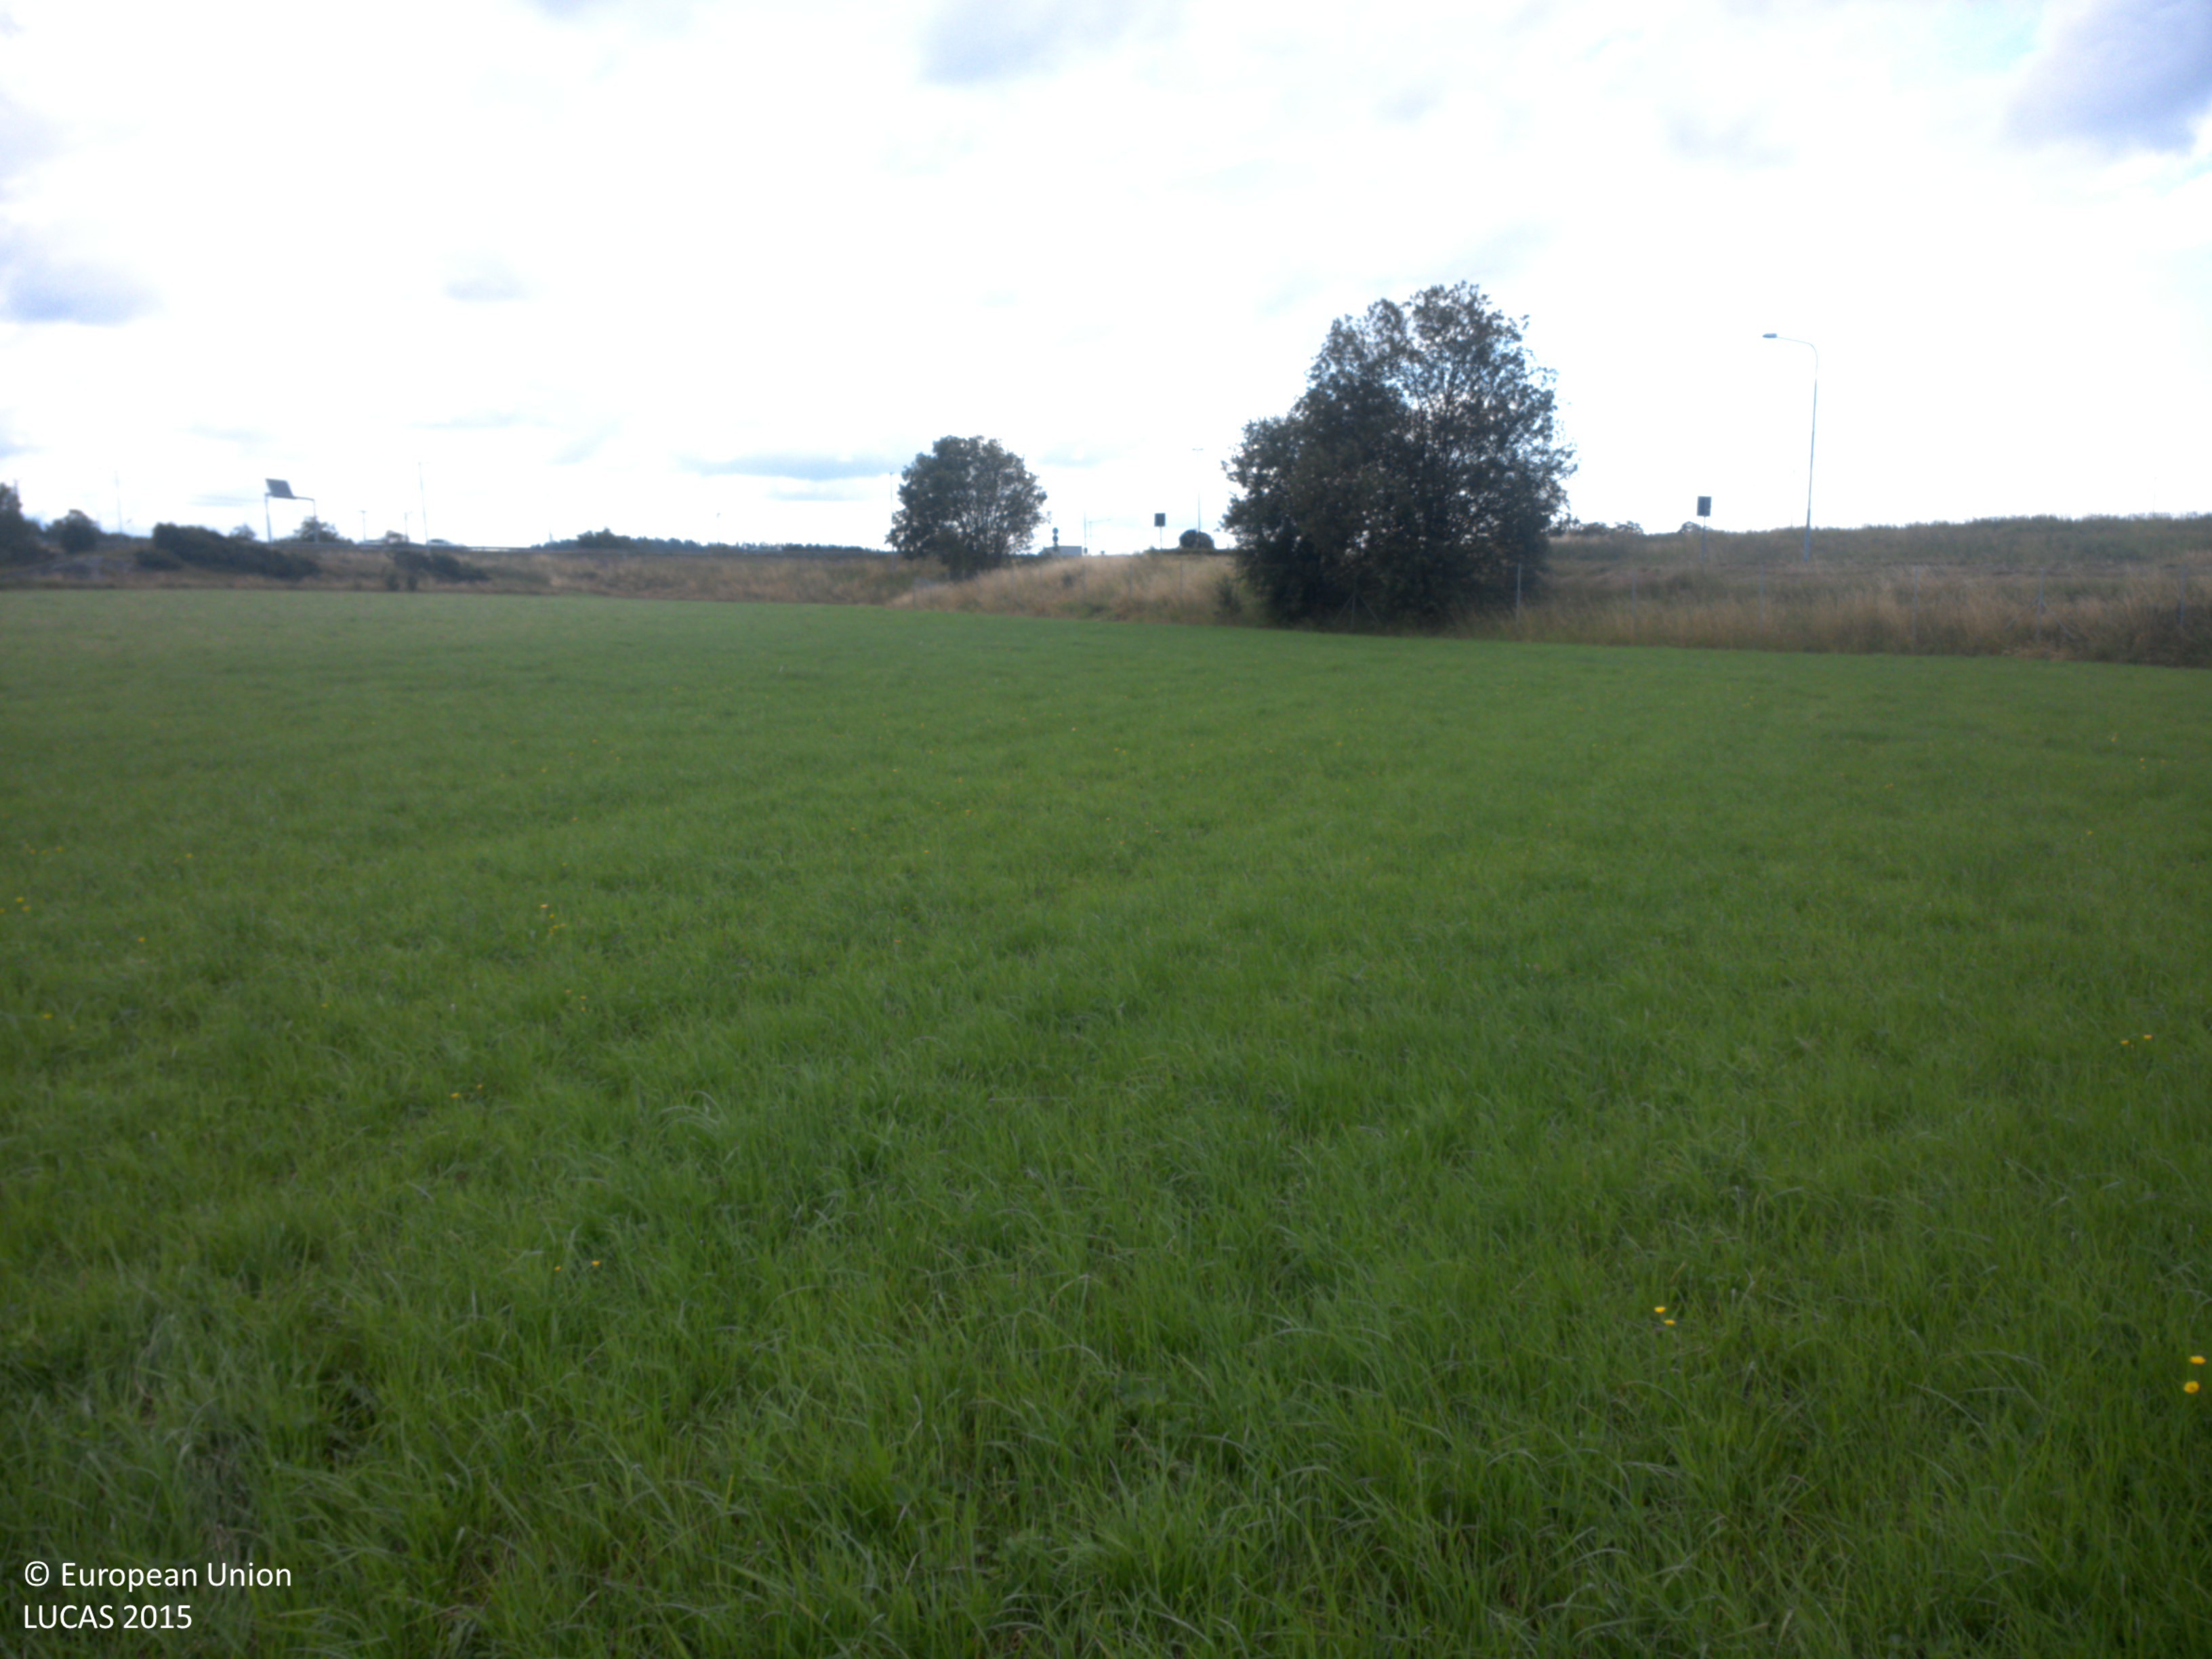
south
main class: Grassland
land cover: Grassland without tree/shrub cover
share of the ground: > 75 %
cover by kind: herbaceous plants 100 %
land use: Agriculture (excluding fallow land and kitchen gardens)
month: July
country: SE
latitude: 58.0270
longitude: 11.8422
